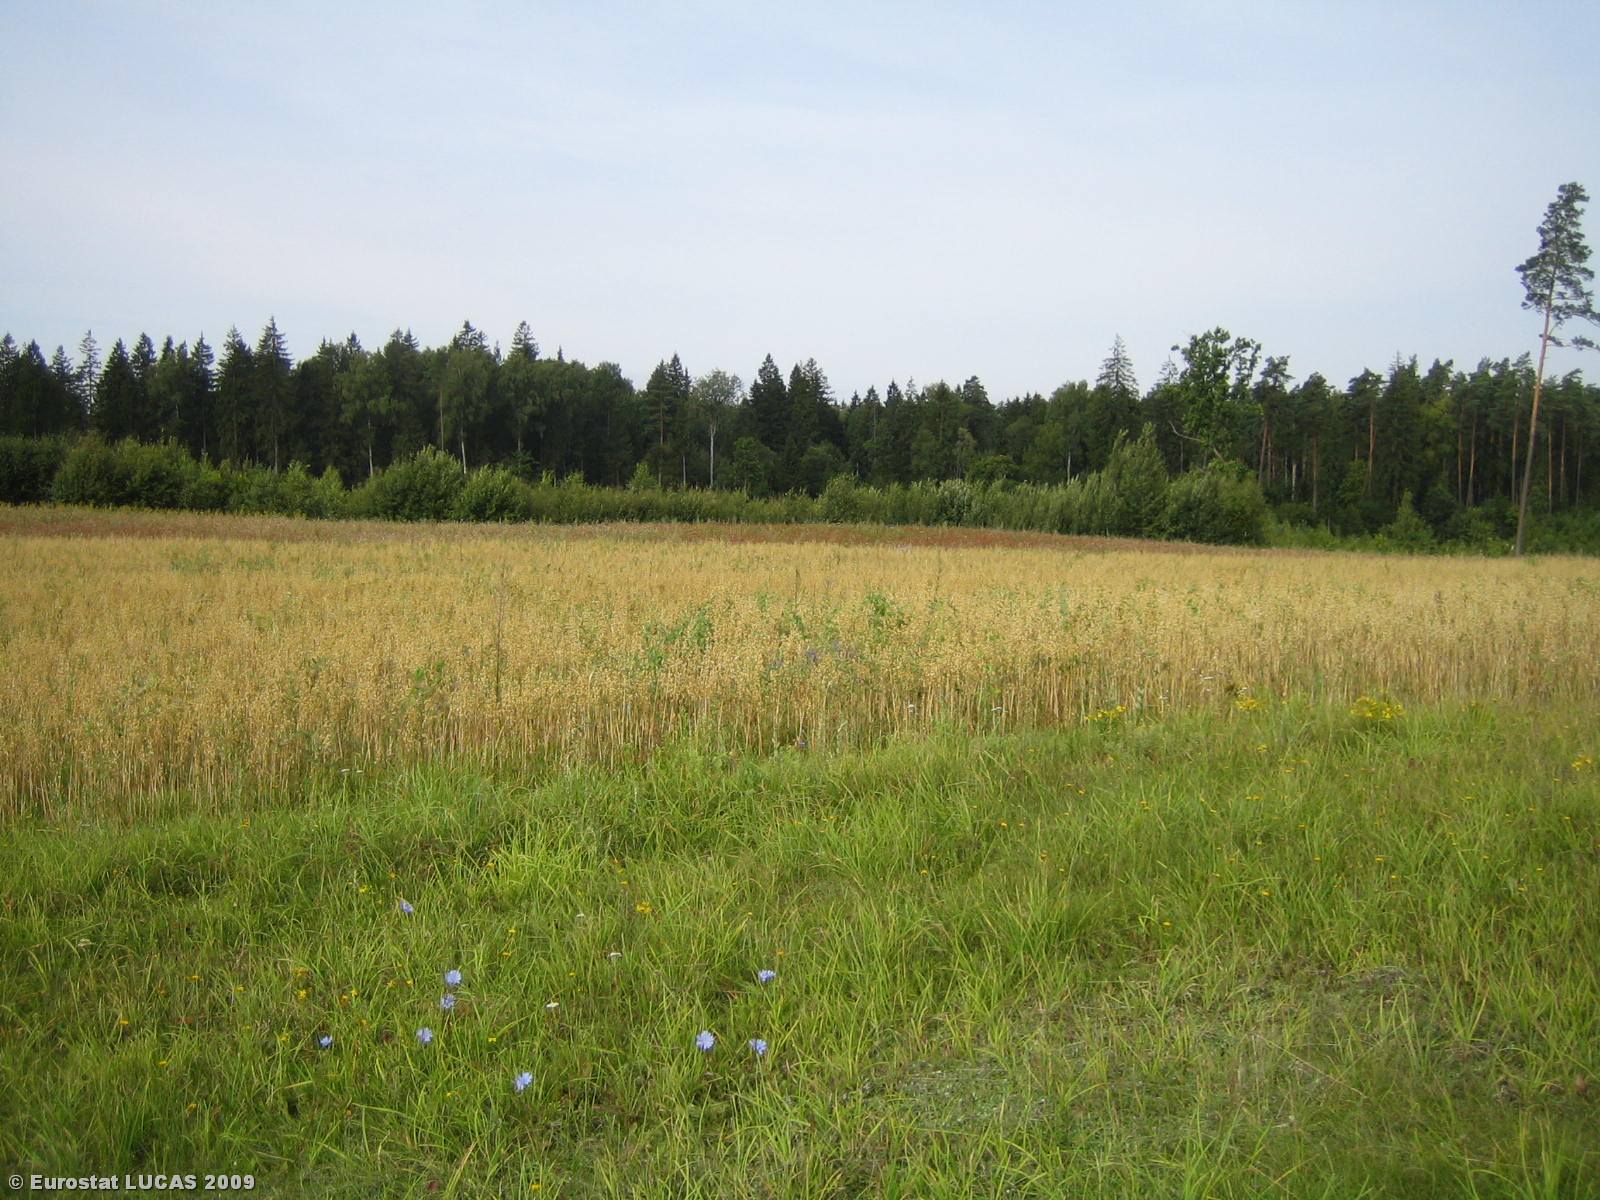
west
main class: Grassland
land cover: Grassland without tree/shrub cover
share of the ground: > 75 %
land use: Agriculture (excluding fallow land and kitchen gardens)
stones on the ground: 10 - 25 %
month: August
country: LT
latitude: 54.5804
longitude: 24.7290
